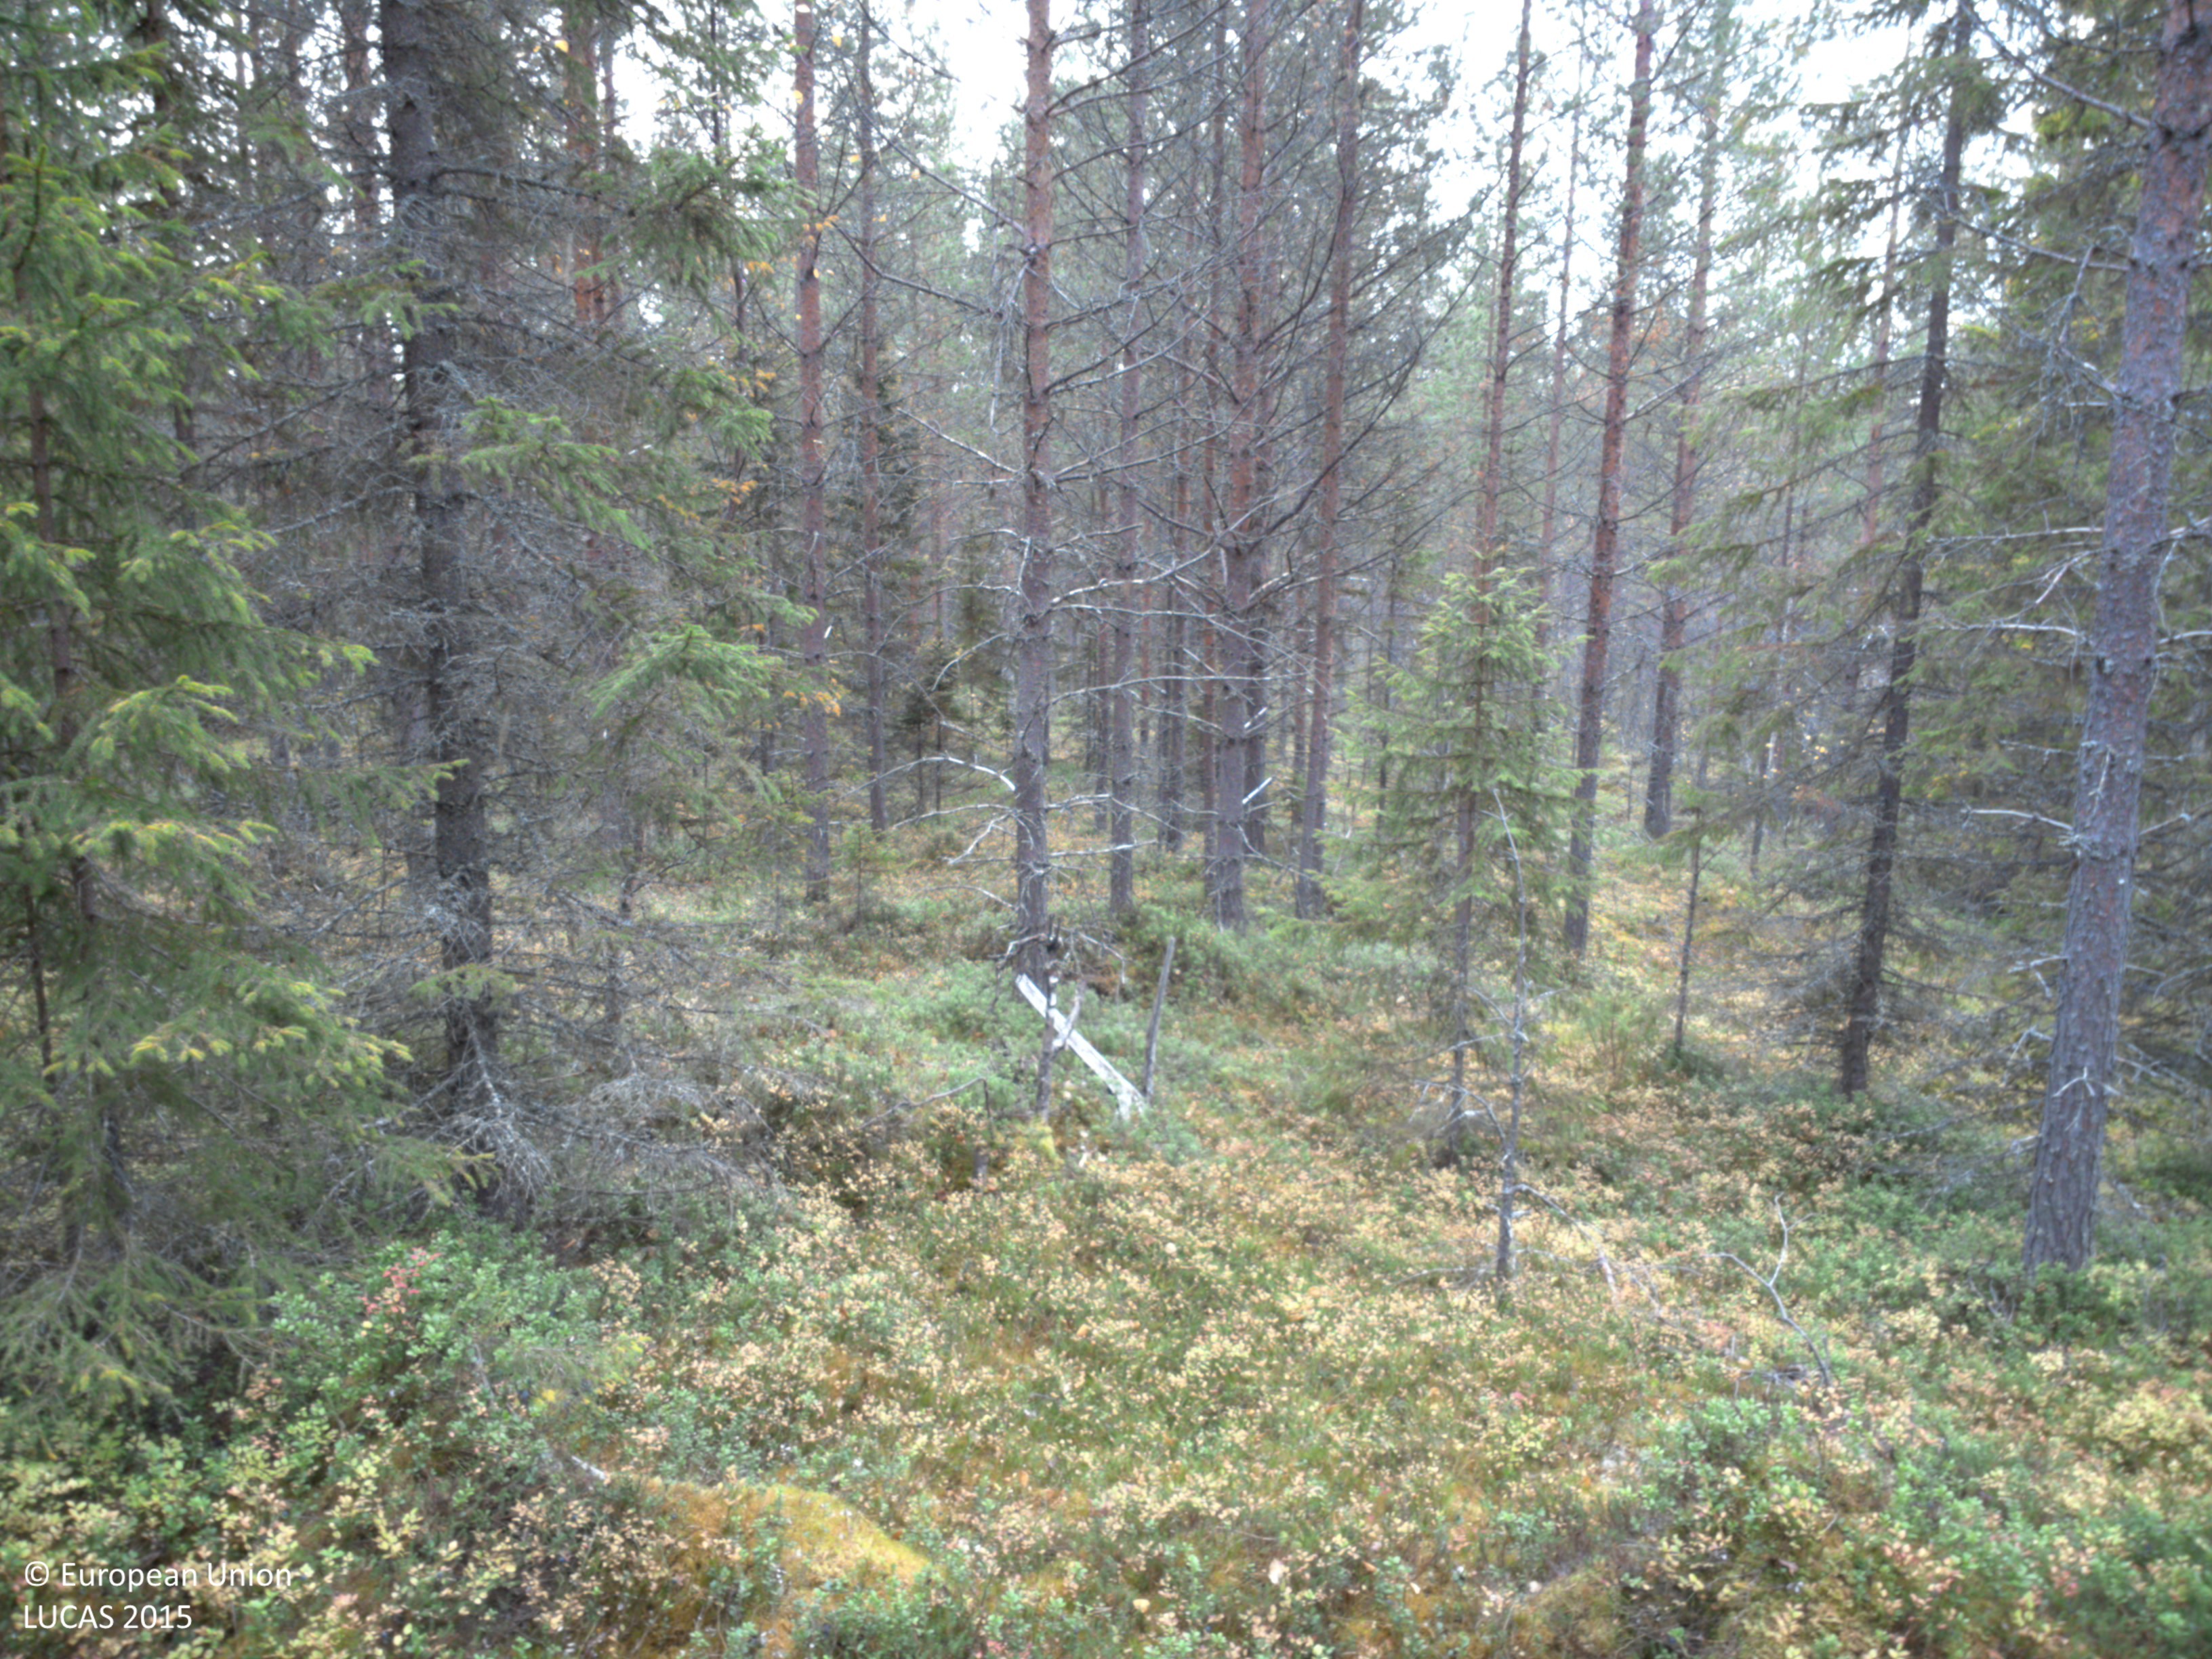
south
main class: Woodland
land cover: Other coniferous woodland
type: boreal forest
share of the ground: > 75 %
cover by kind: coniferous forest trees 80 %, shrubs 10 %, lichens and mosses 10 %
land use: Forestry
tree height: > 5 m
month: October
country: SE
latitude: 64.9536
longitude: 18.1146
